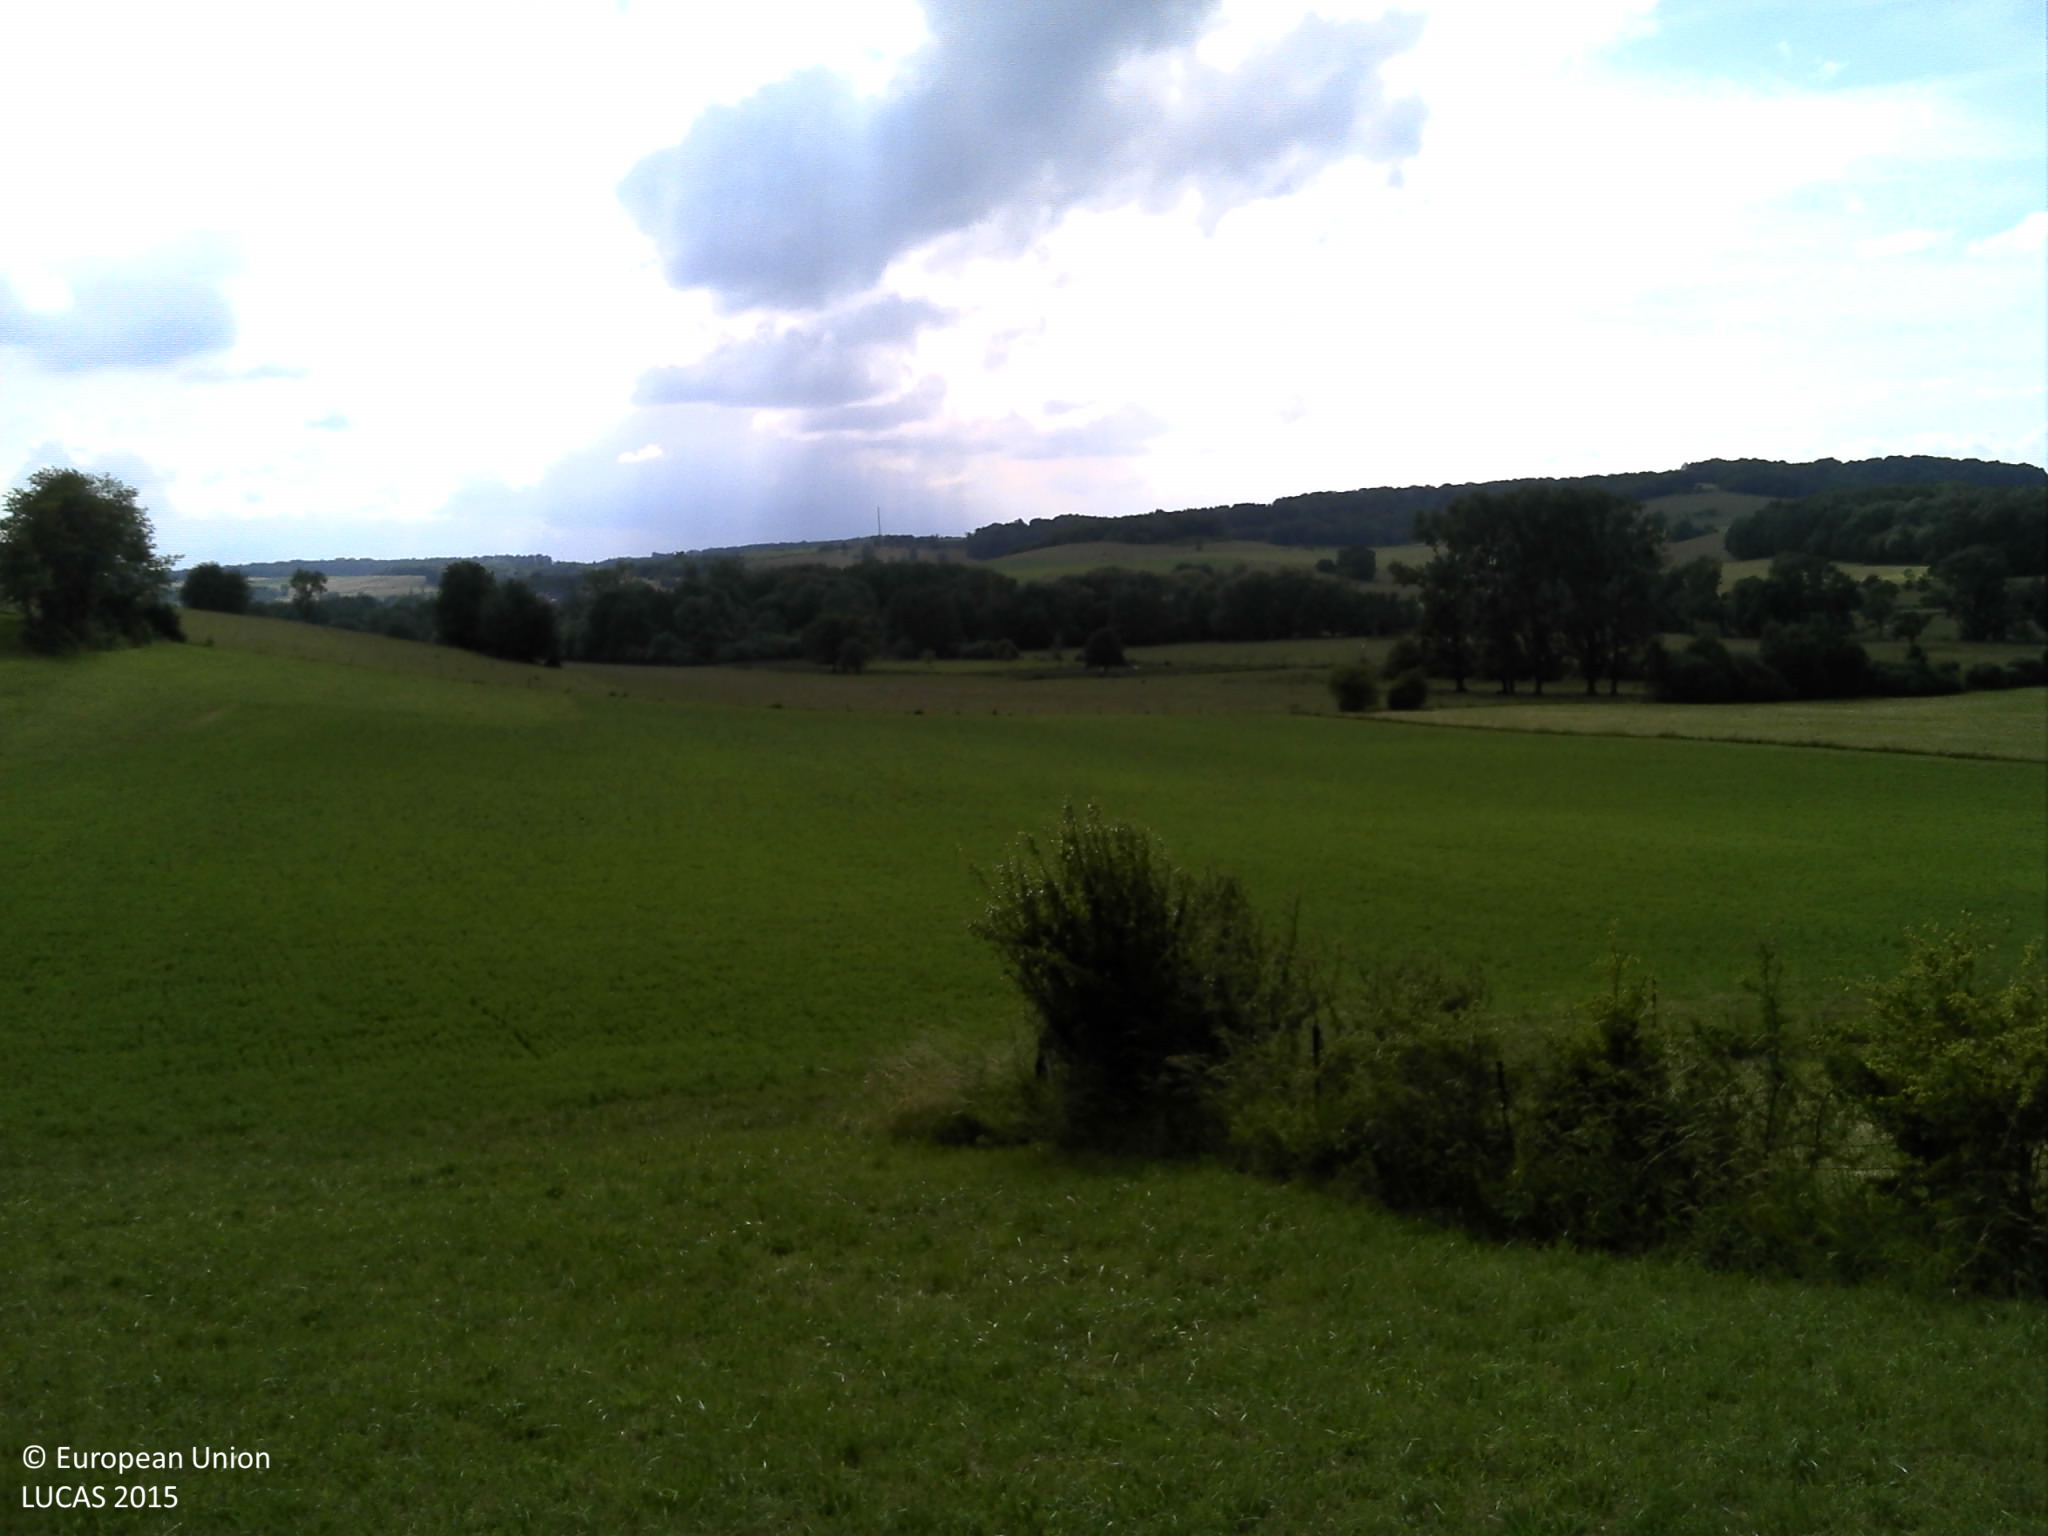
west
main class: Grassland
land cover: Grassland without tree/shrub cover
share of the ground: > 75 %
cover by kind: herbaceous plants 100 %
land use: Agriculture (excluding fallow land and kitchen gardens)
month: June
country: FR
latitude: 49.4472
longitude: 5.0736
